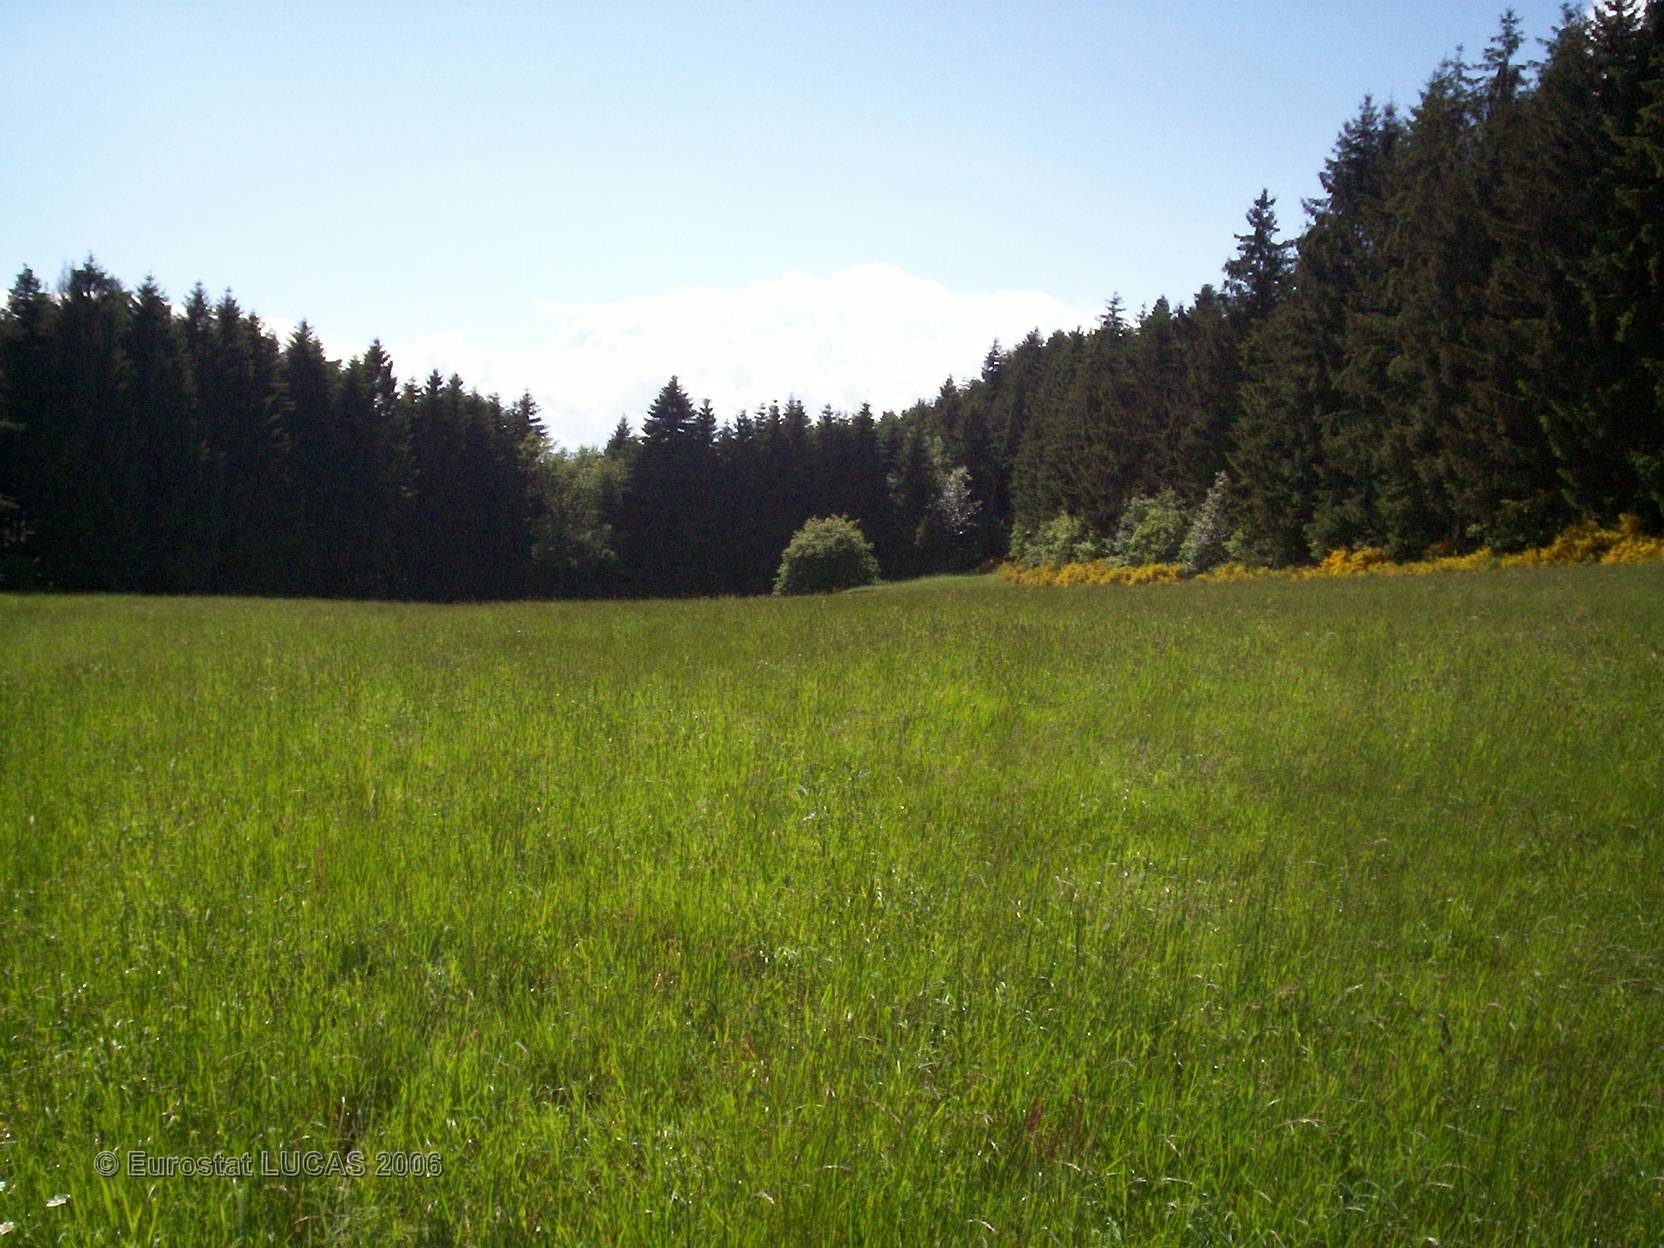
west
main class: Grassland
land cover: Grassland without tree/shrub cover
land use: Agriculture (excluding fallow land and kitchen gardens)
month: May
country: FR
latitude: 48.2921
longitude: 7.0491
